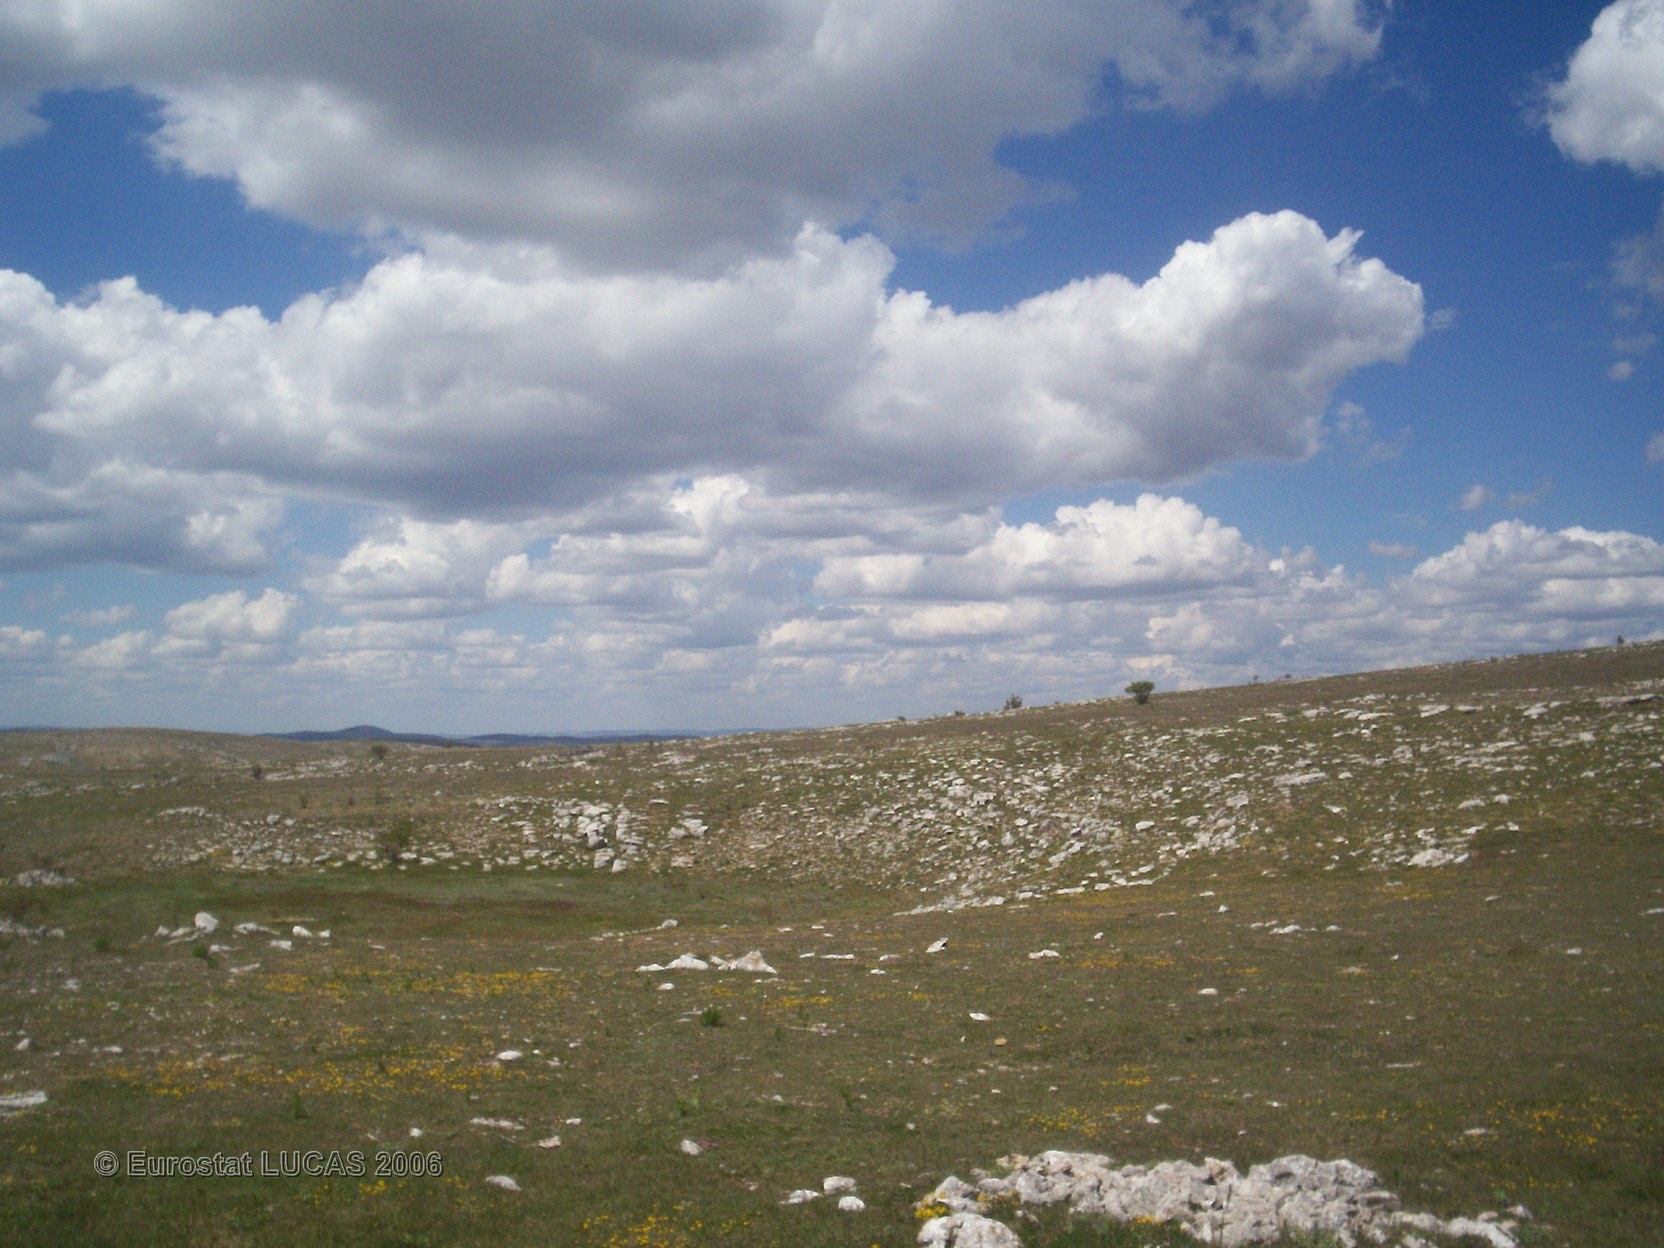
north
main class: Grassland
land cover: Grassland without tree/shrub cover
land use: Agriculture (excluding fallow land and kitchen gardens)
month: June
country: FR
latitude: 44.2165
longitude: 3.4601
